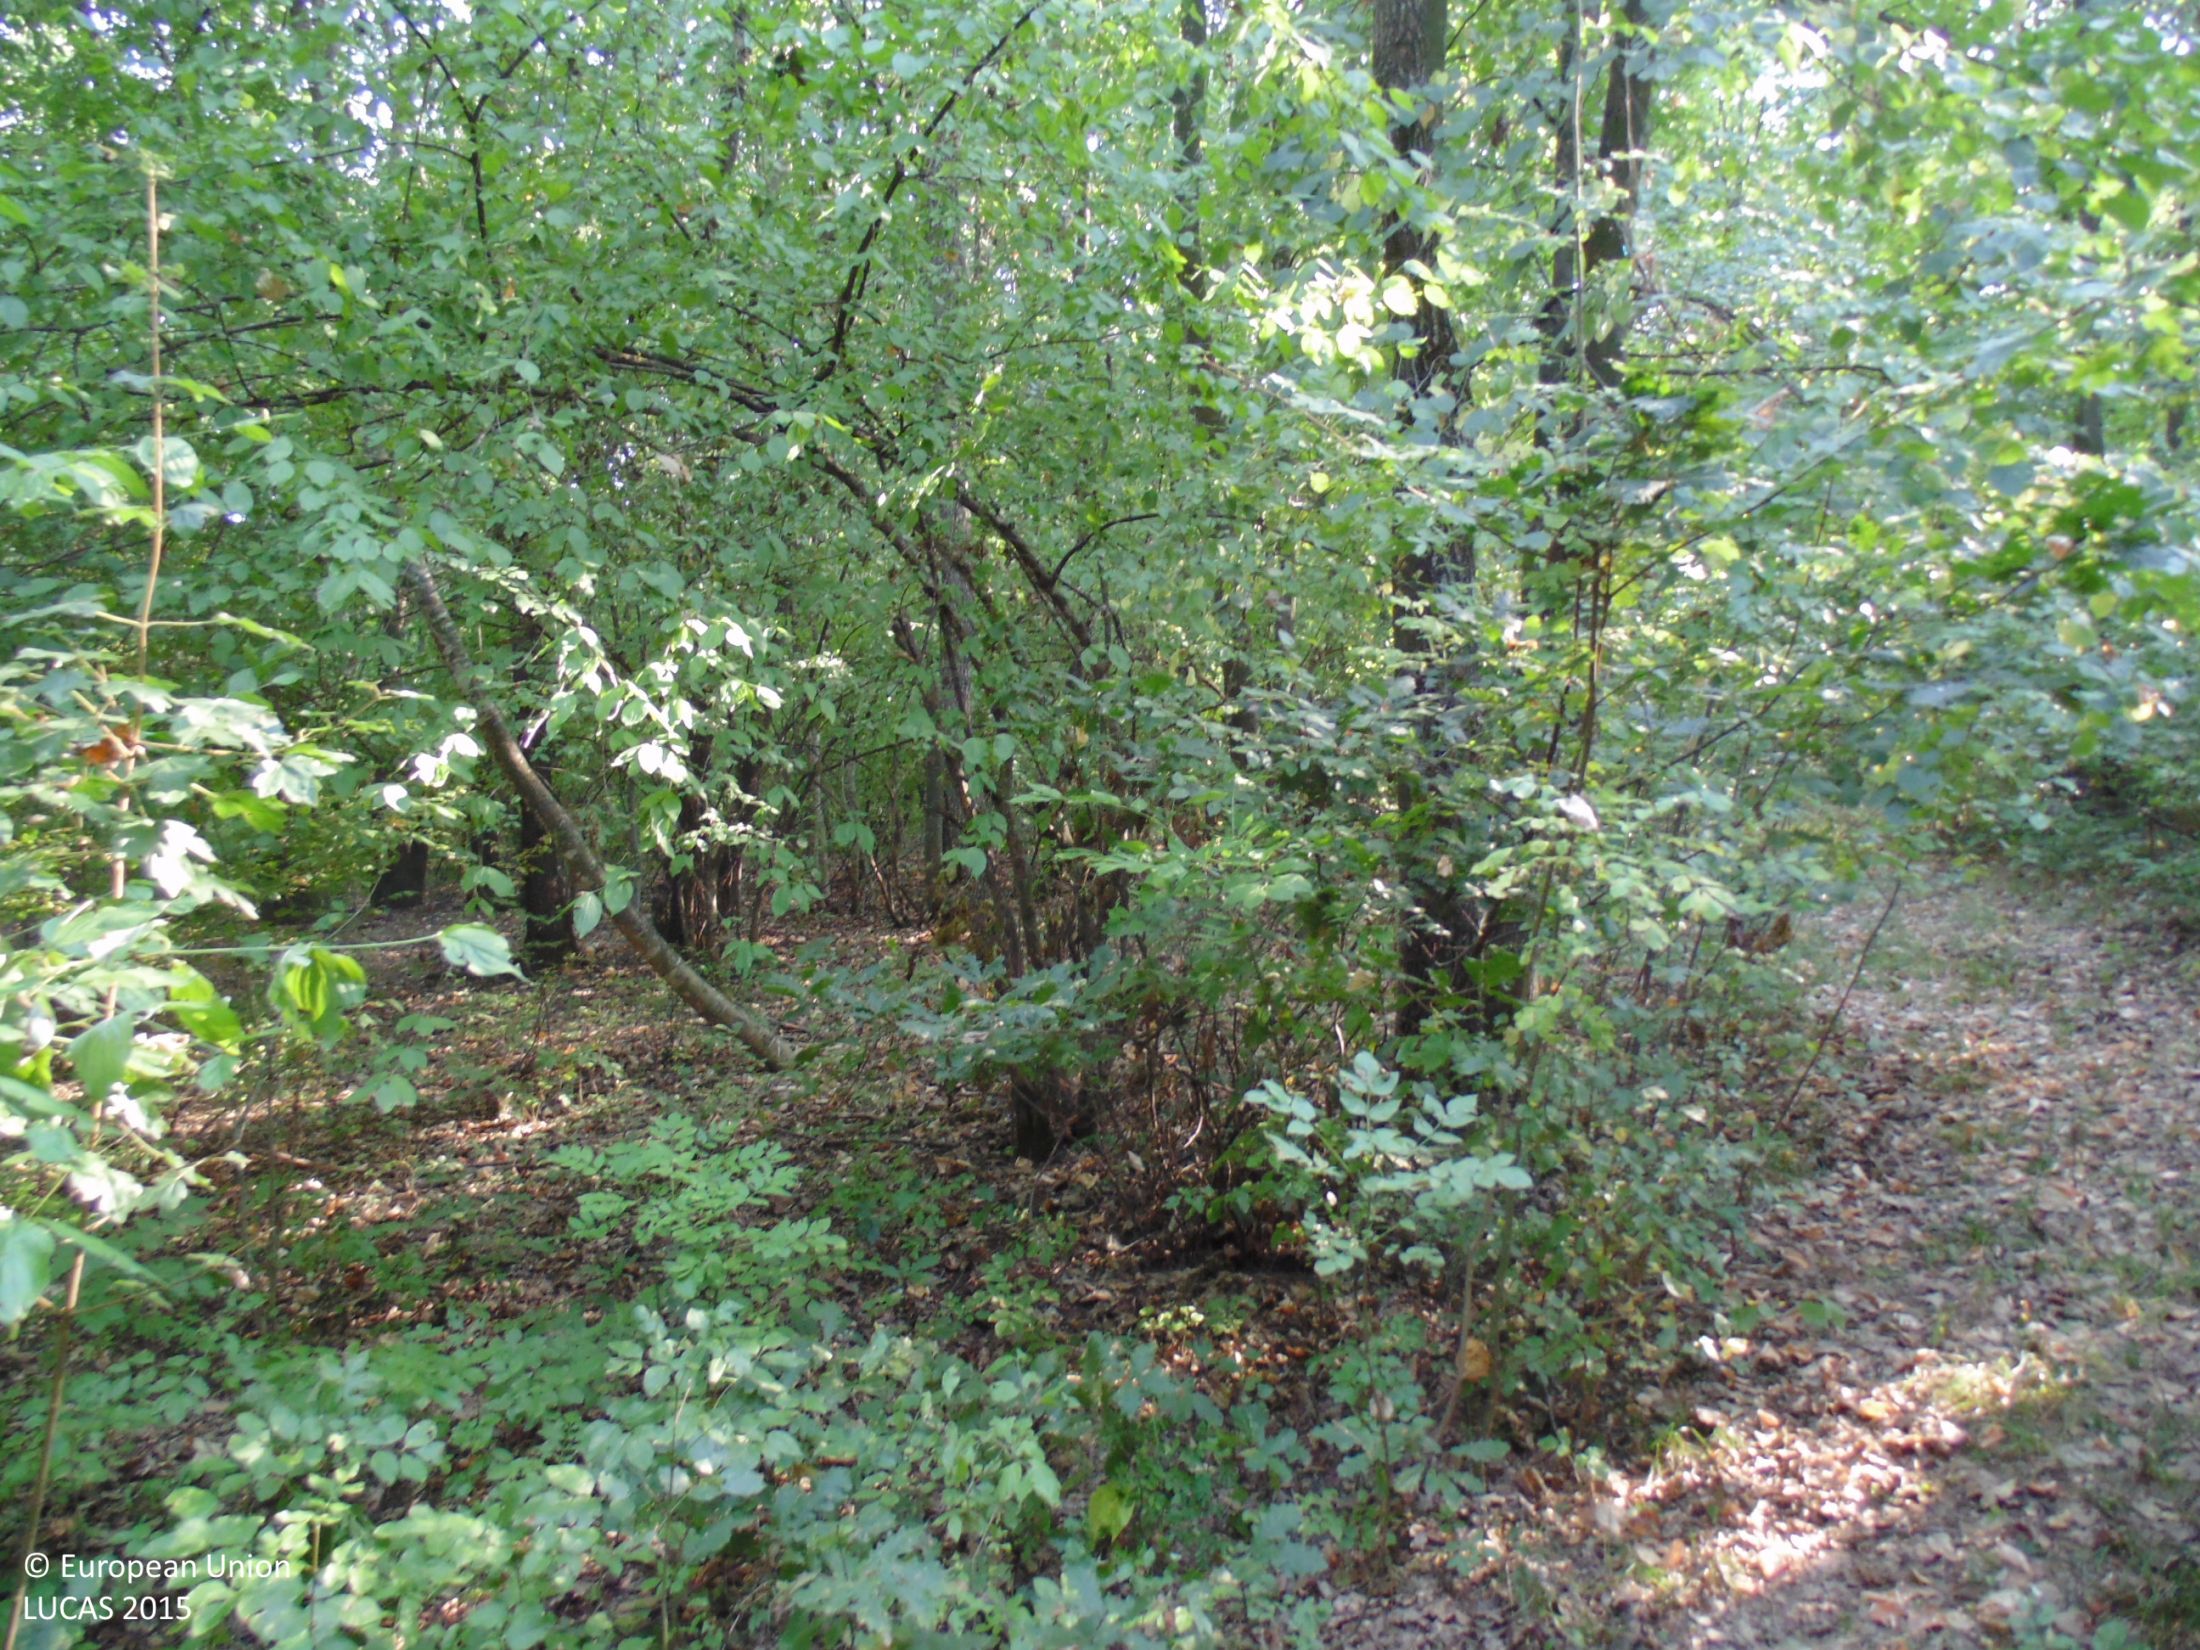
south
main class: Woodland
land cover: Broadleaved woodland
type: mesophytic deciduous forest
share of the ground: > 75 %
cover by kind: broadleaved forest trees 90 %, shrubs 5 %, unconsolidated bare surface 5 %
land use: Forestry
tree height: > 5 m
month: September
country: BG
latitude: 43.8534
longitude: 26.9009
